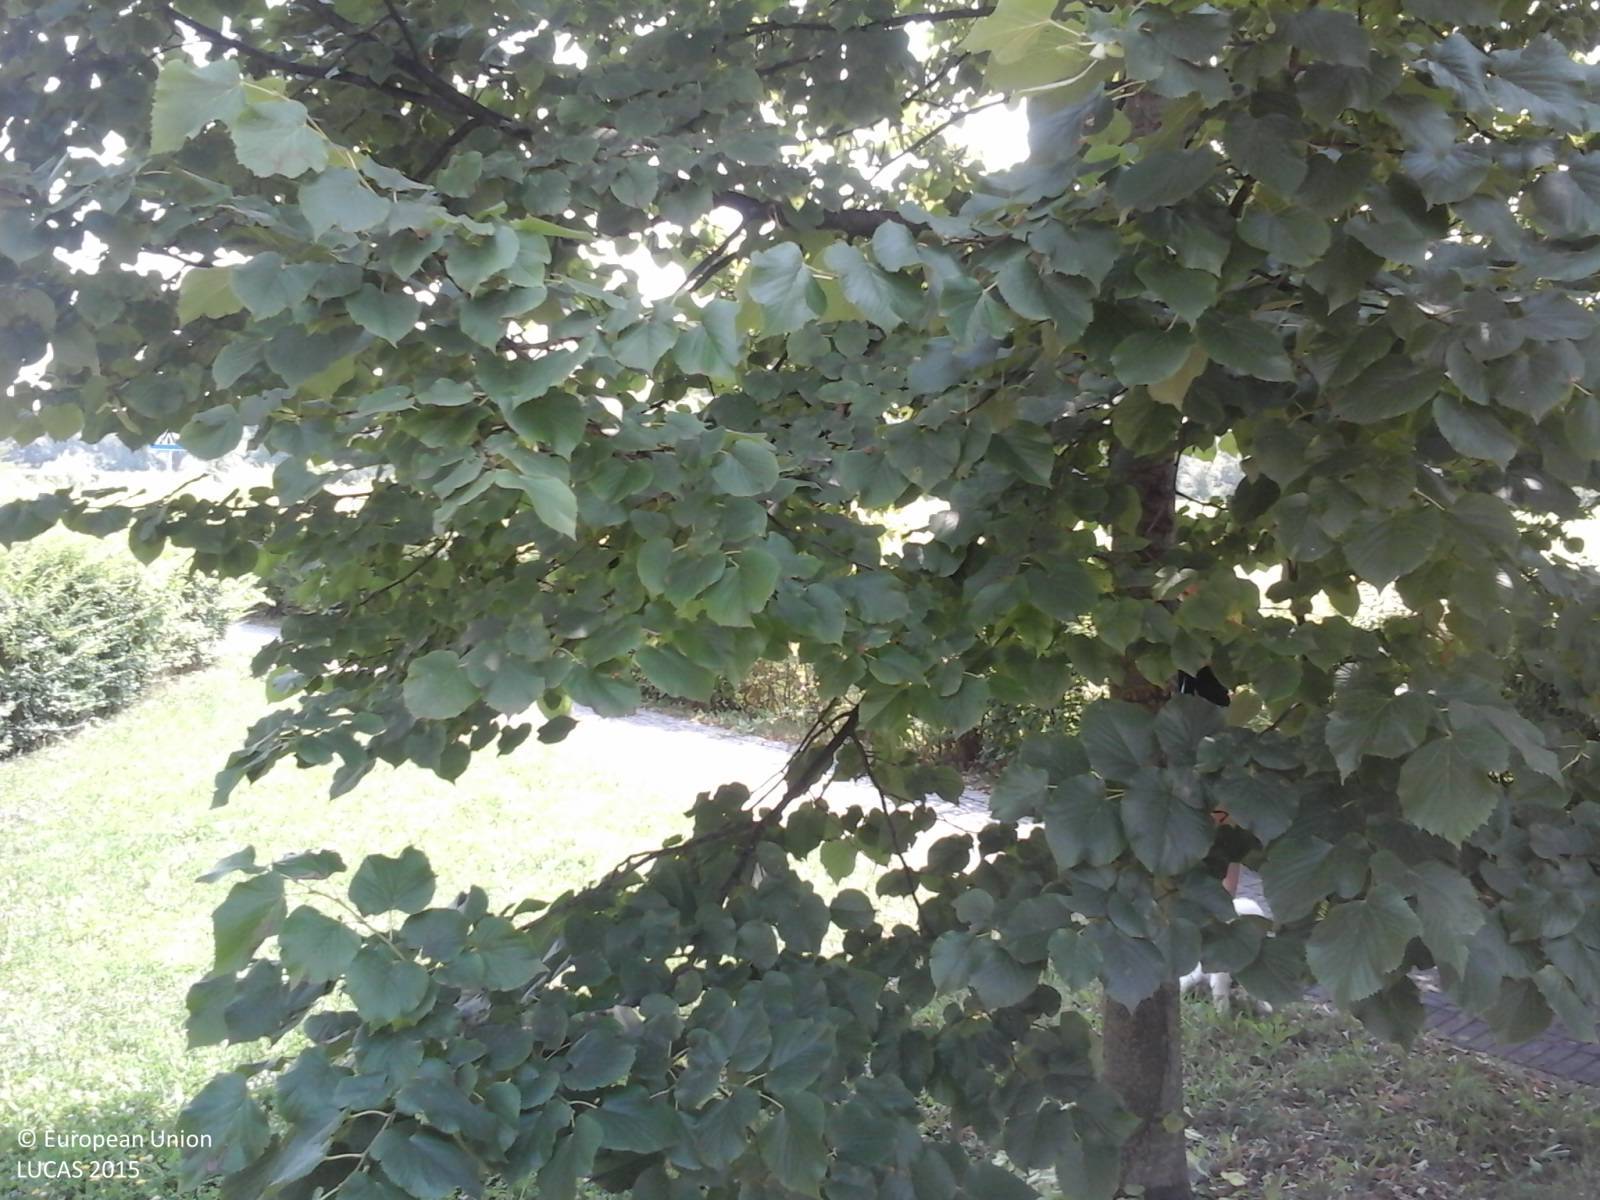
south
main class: Grassland
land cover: Grassland with sparse tree/shrub cover
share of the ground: > 75 %
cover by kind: herbaceous plants 95 %, broadleaved forest trees 5 %
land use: Community services
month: July
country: IT
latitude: 45.9395
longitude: 12.6666
